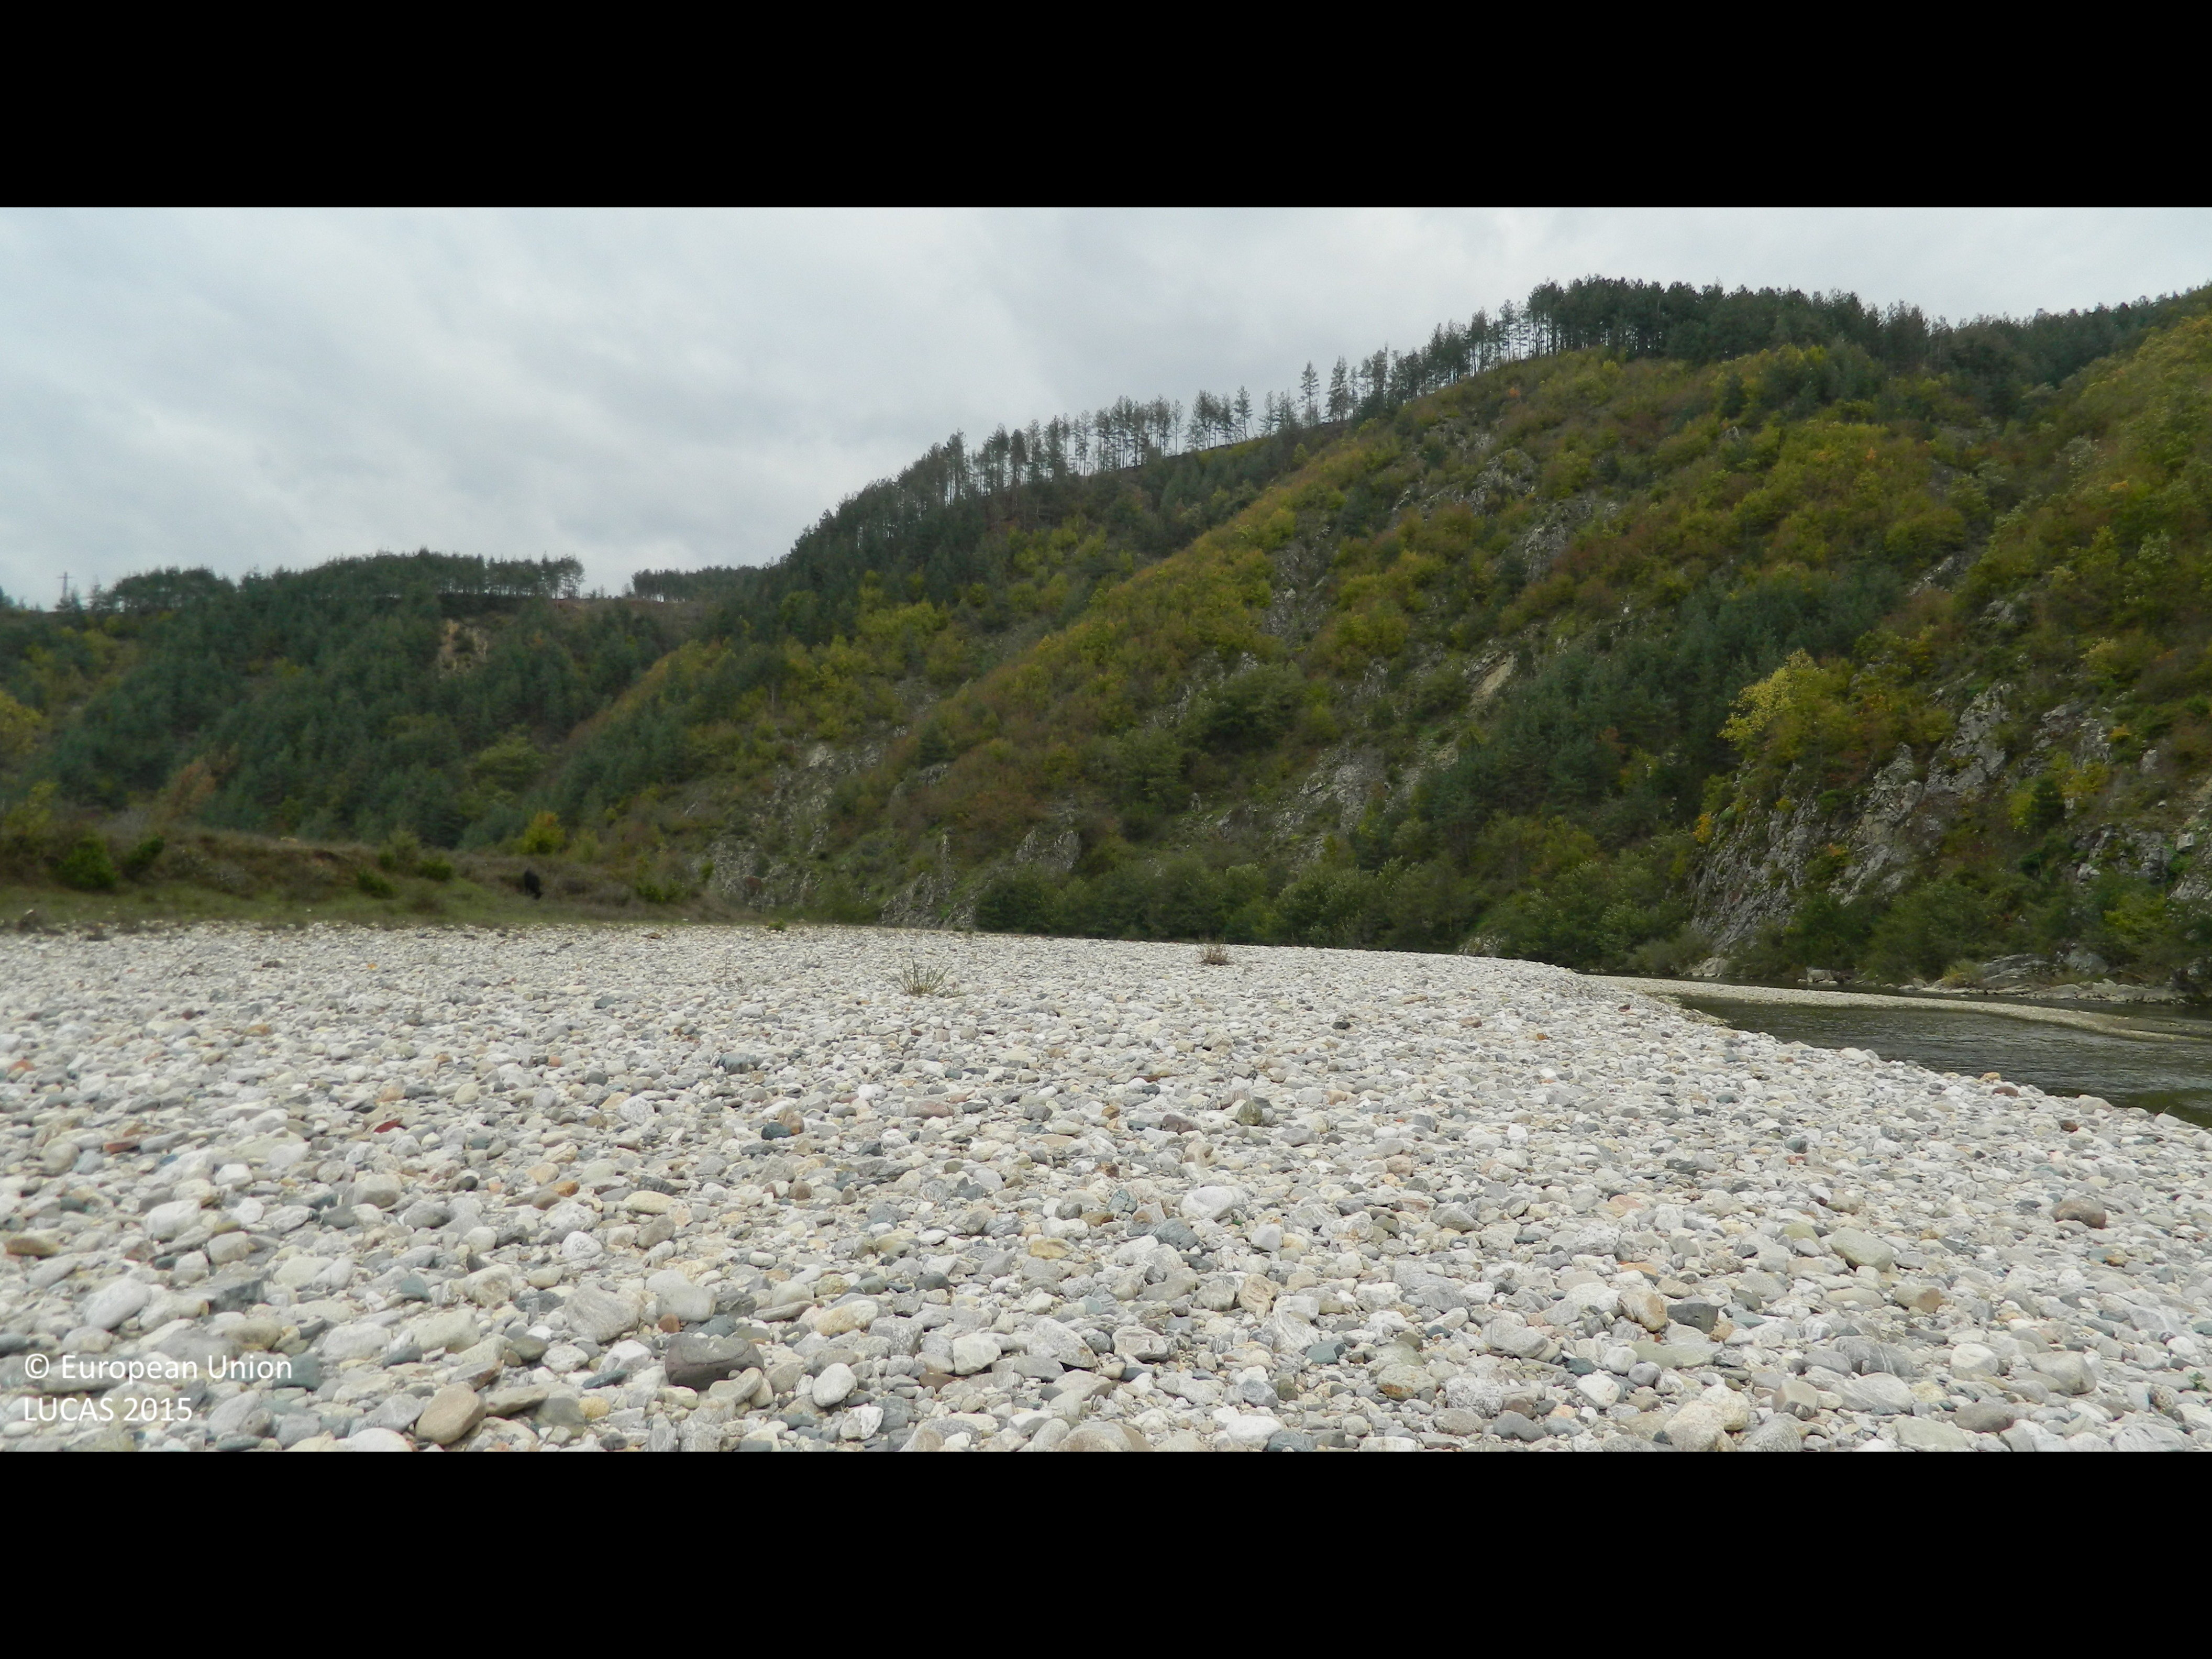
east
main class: Woodland
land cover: Pine dominated coniferous woodland
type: hemiboreal forest and nemoral coniferous forest and mixed broadleaved-coniferous forest
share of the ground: > 75 %
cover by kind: coniferous forest trees 95 %, broadleaved forest trees 5 %
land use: Forestry
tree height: > 5 m
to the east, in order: Pine dominated coniferous woodland; Pine dominated mixed woodland; Broadleaved woodland; Pine dominated mixed woodland
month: October
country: BG
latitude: 41.3601
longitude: 25.2684
